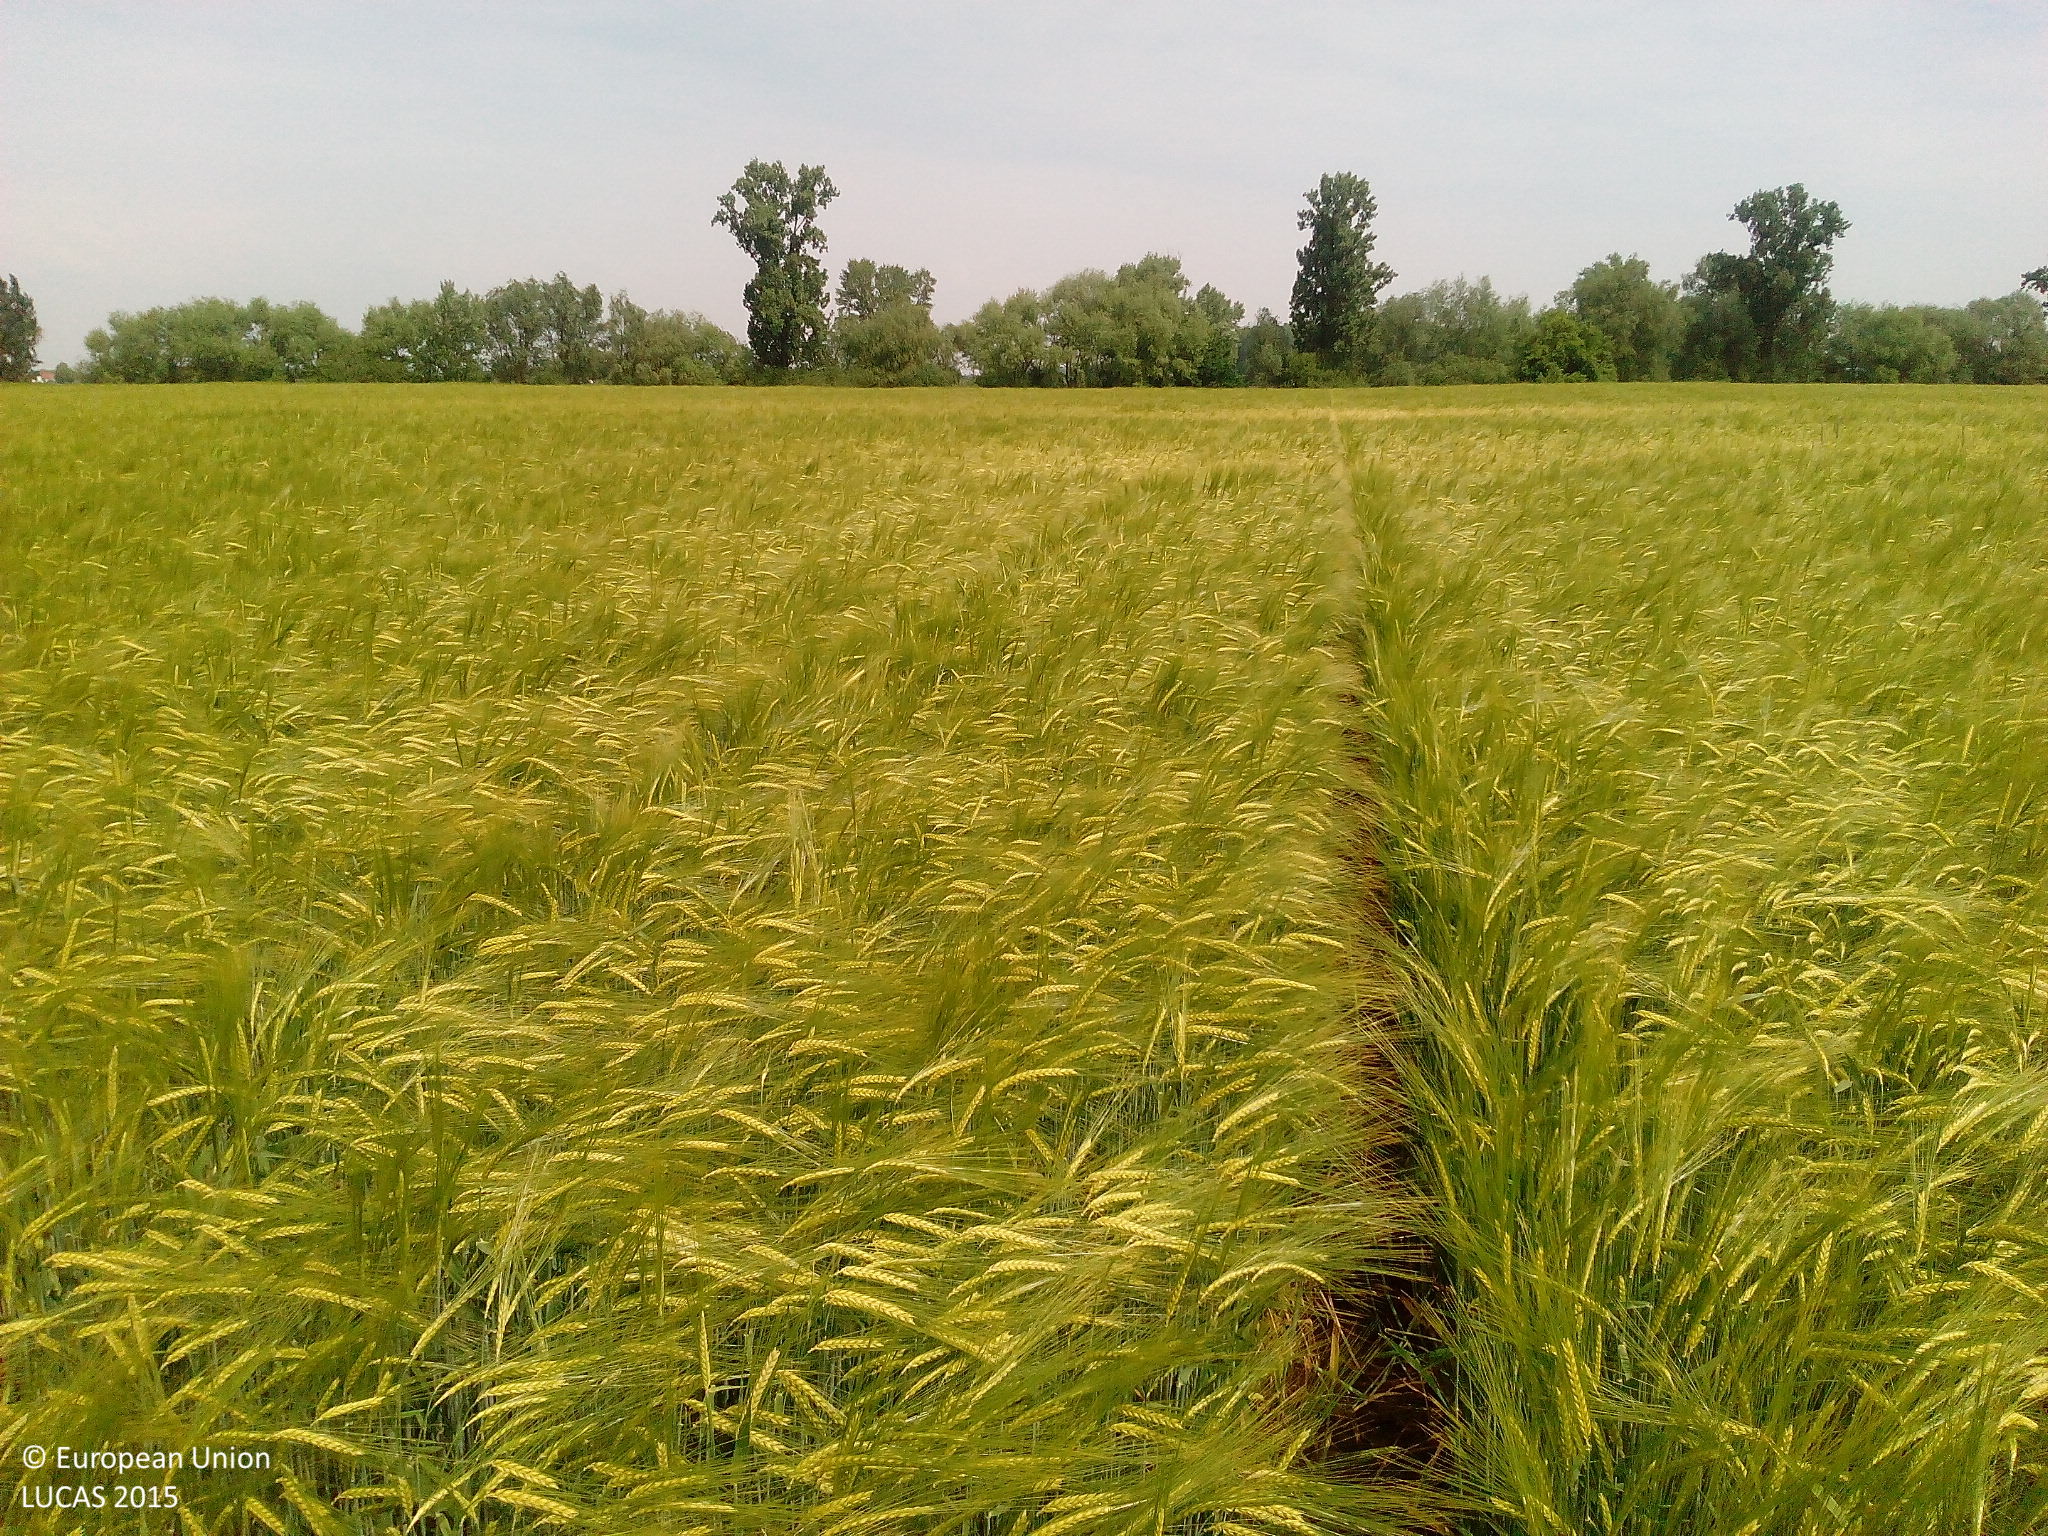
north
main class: Cropland
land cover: Barley
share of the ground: > 75 %
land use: Agriculture (excluding fallow land and kitchen gardens)
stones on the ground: < 10 %
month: May
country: DE
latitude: 49.8328
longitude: 8.5128
